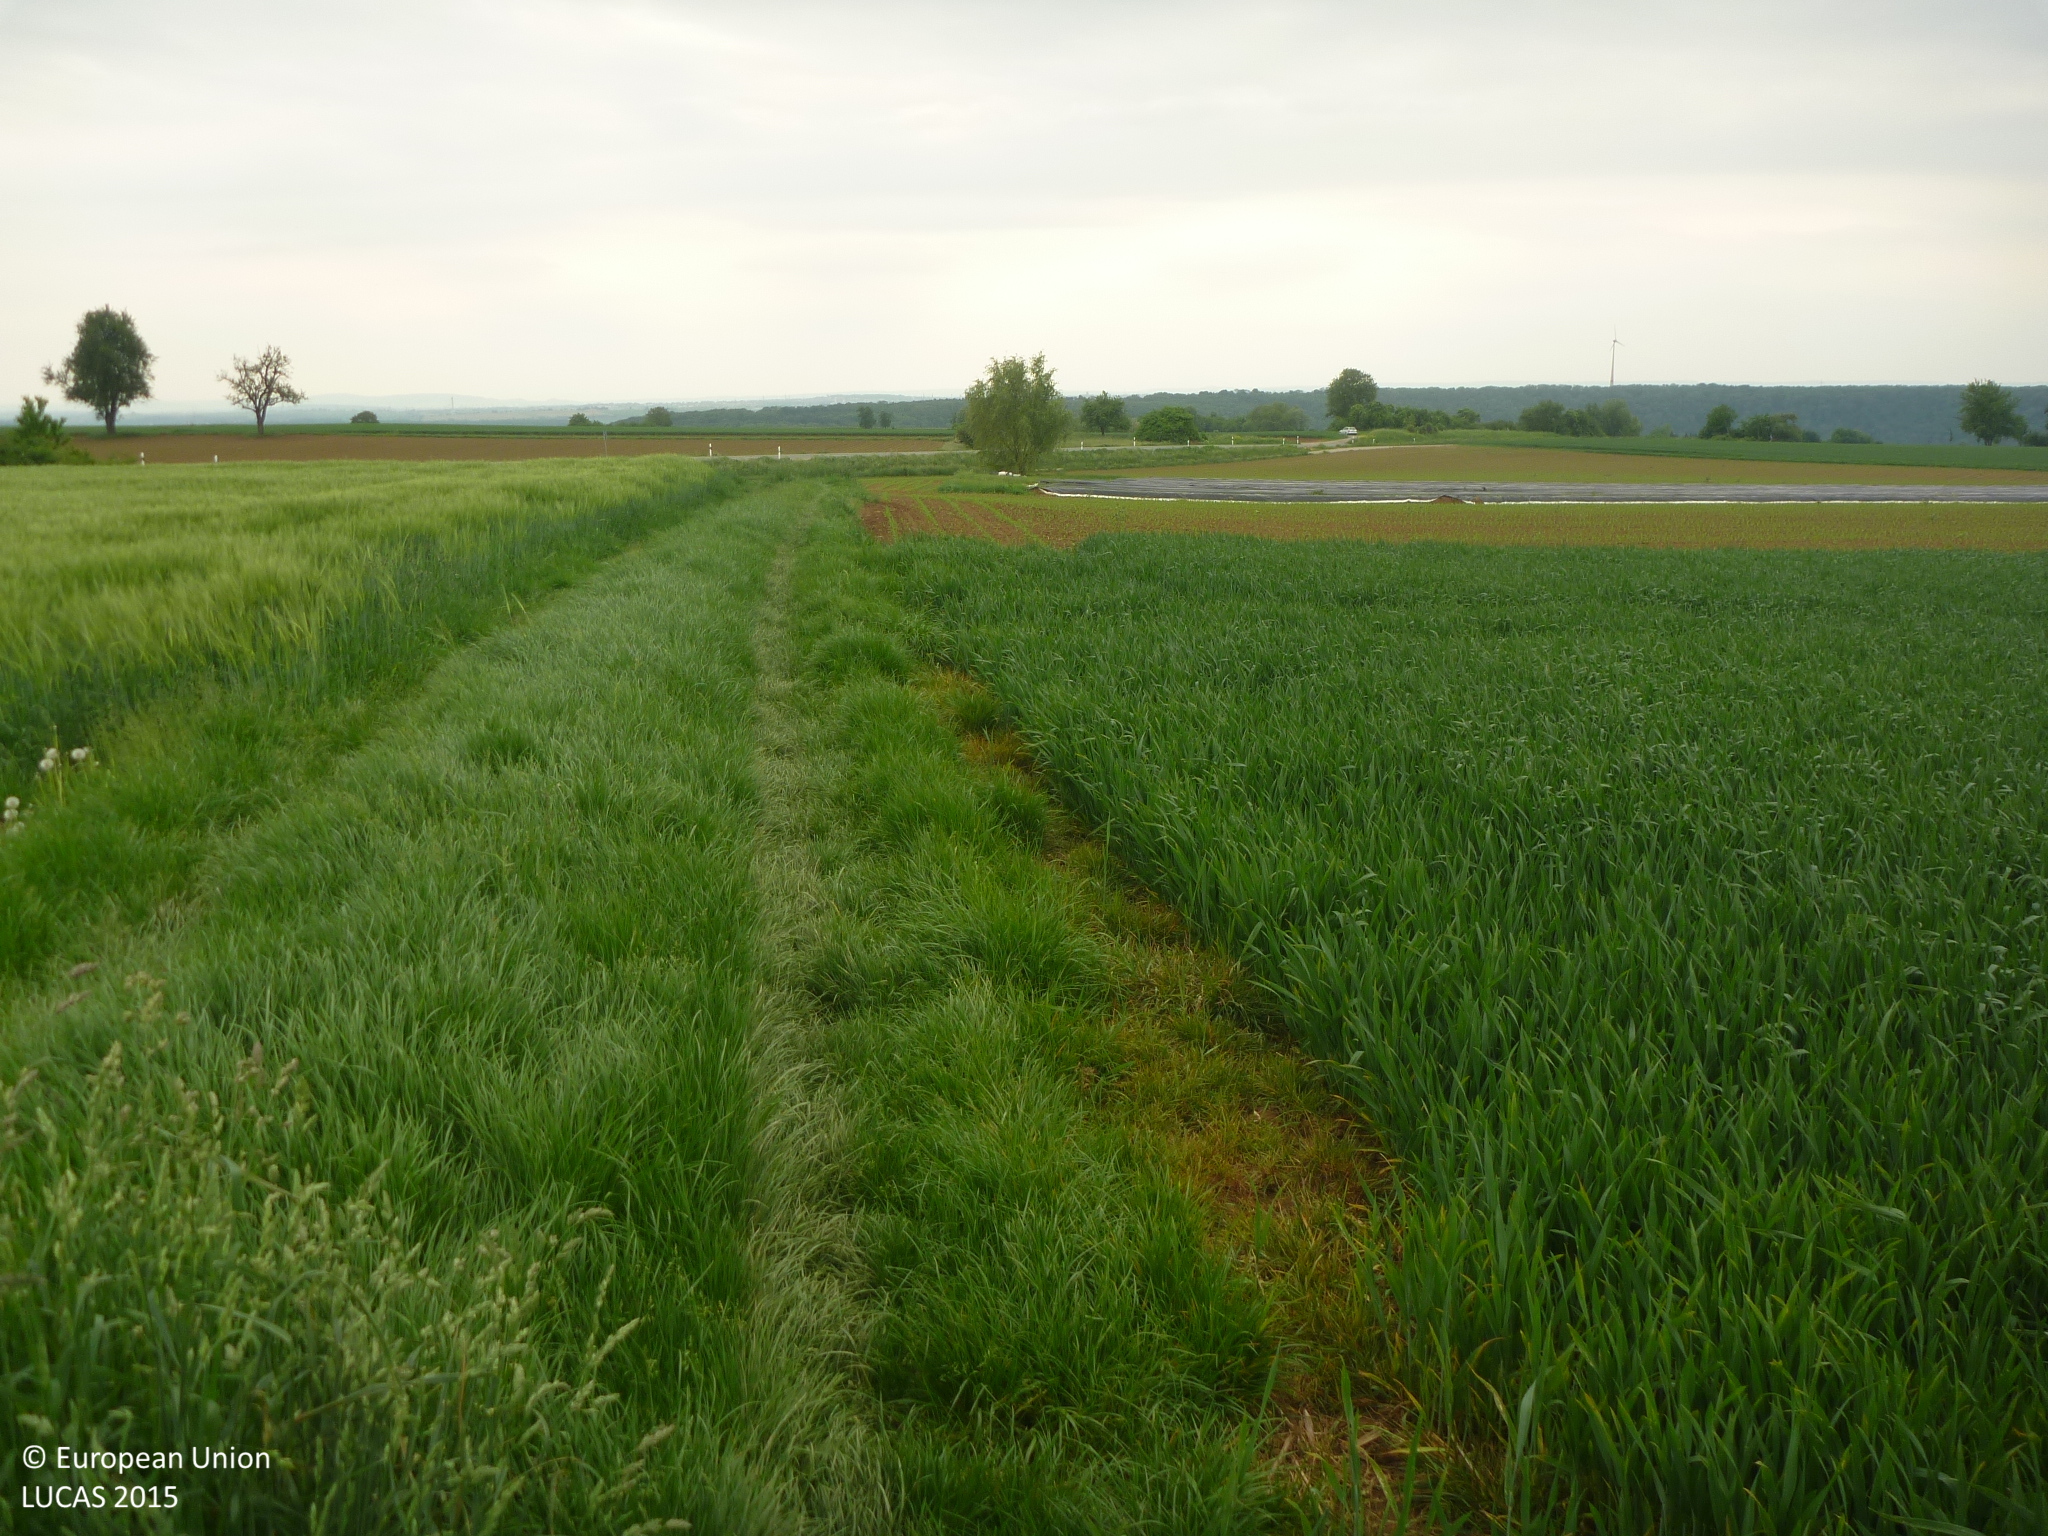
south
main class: Cropland
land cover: Common wheat
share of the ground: > 75 %
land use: Agriculture (excluding fallow land and kitchen gardens)
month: May
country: DE
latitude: 49.0123
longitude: 9.1937
